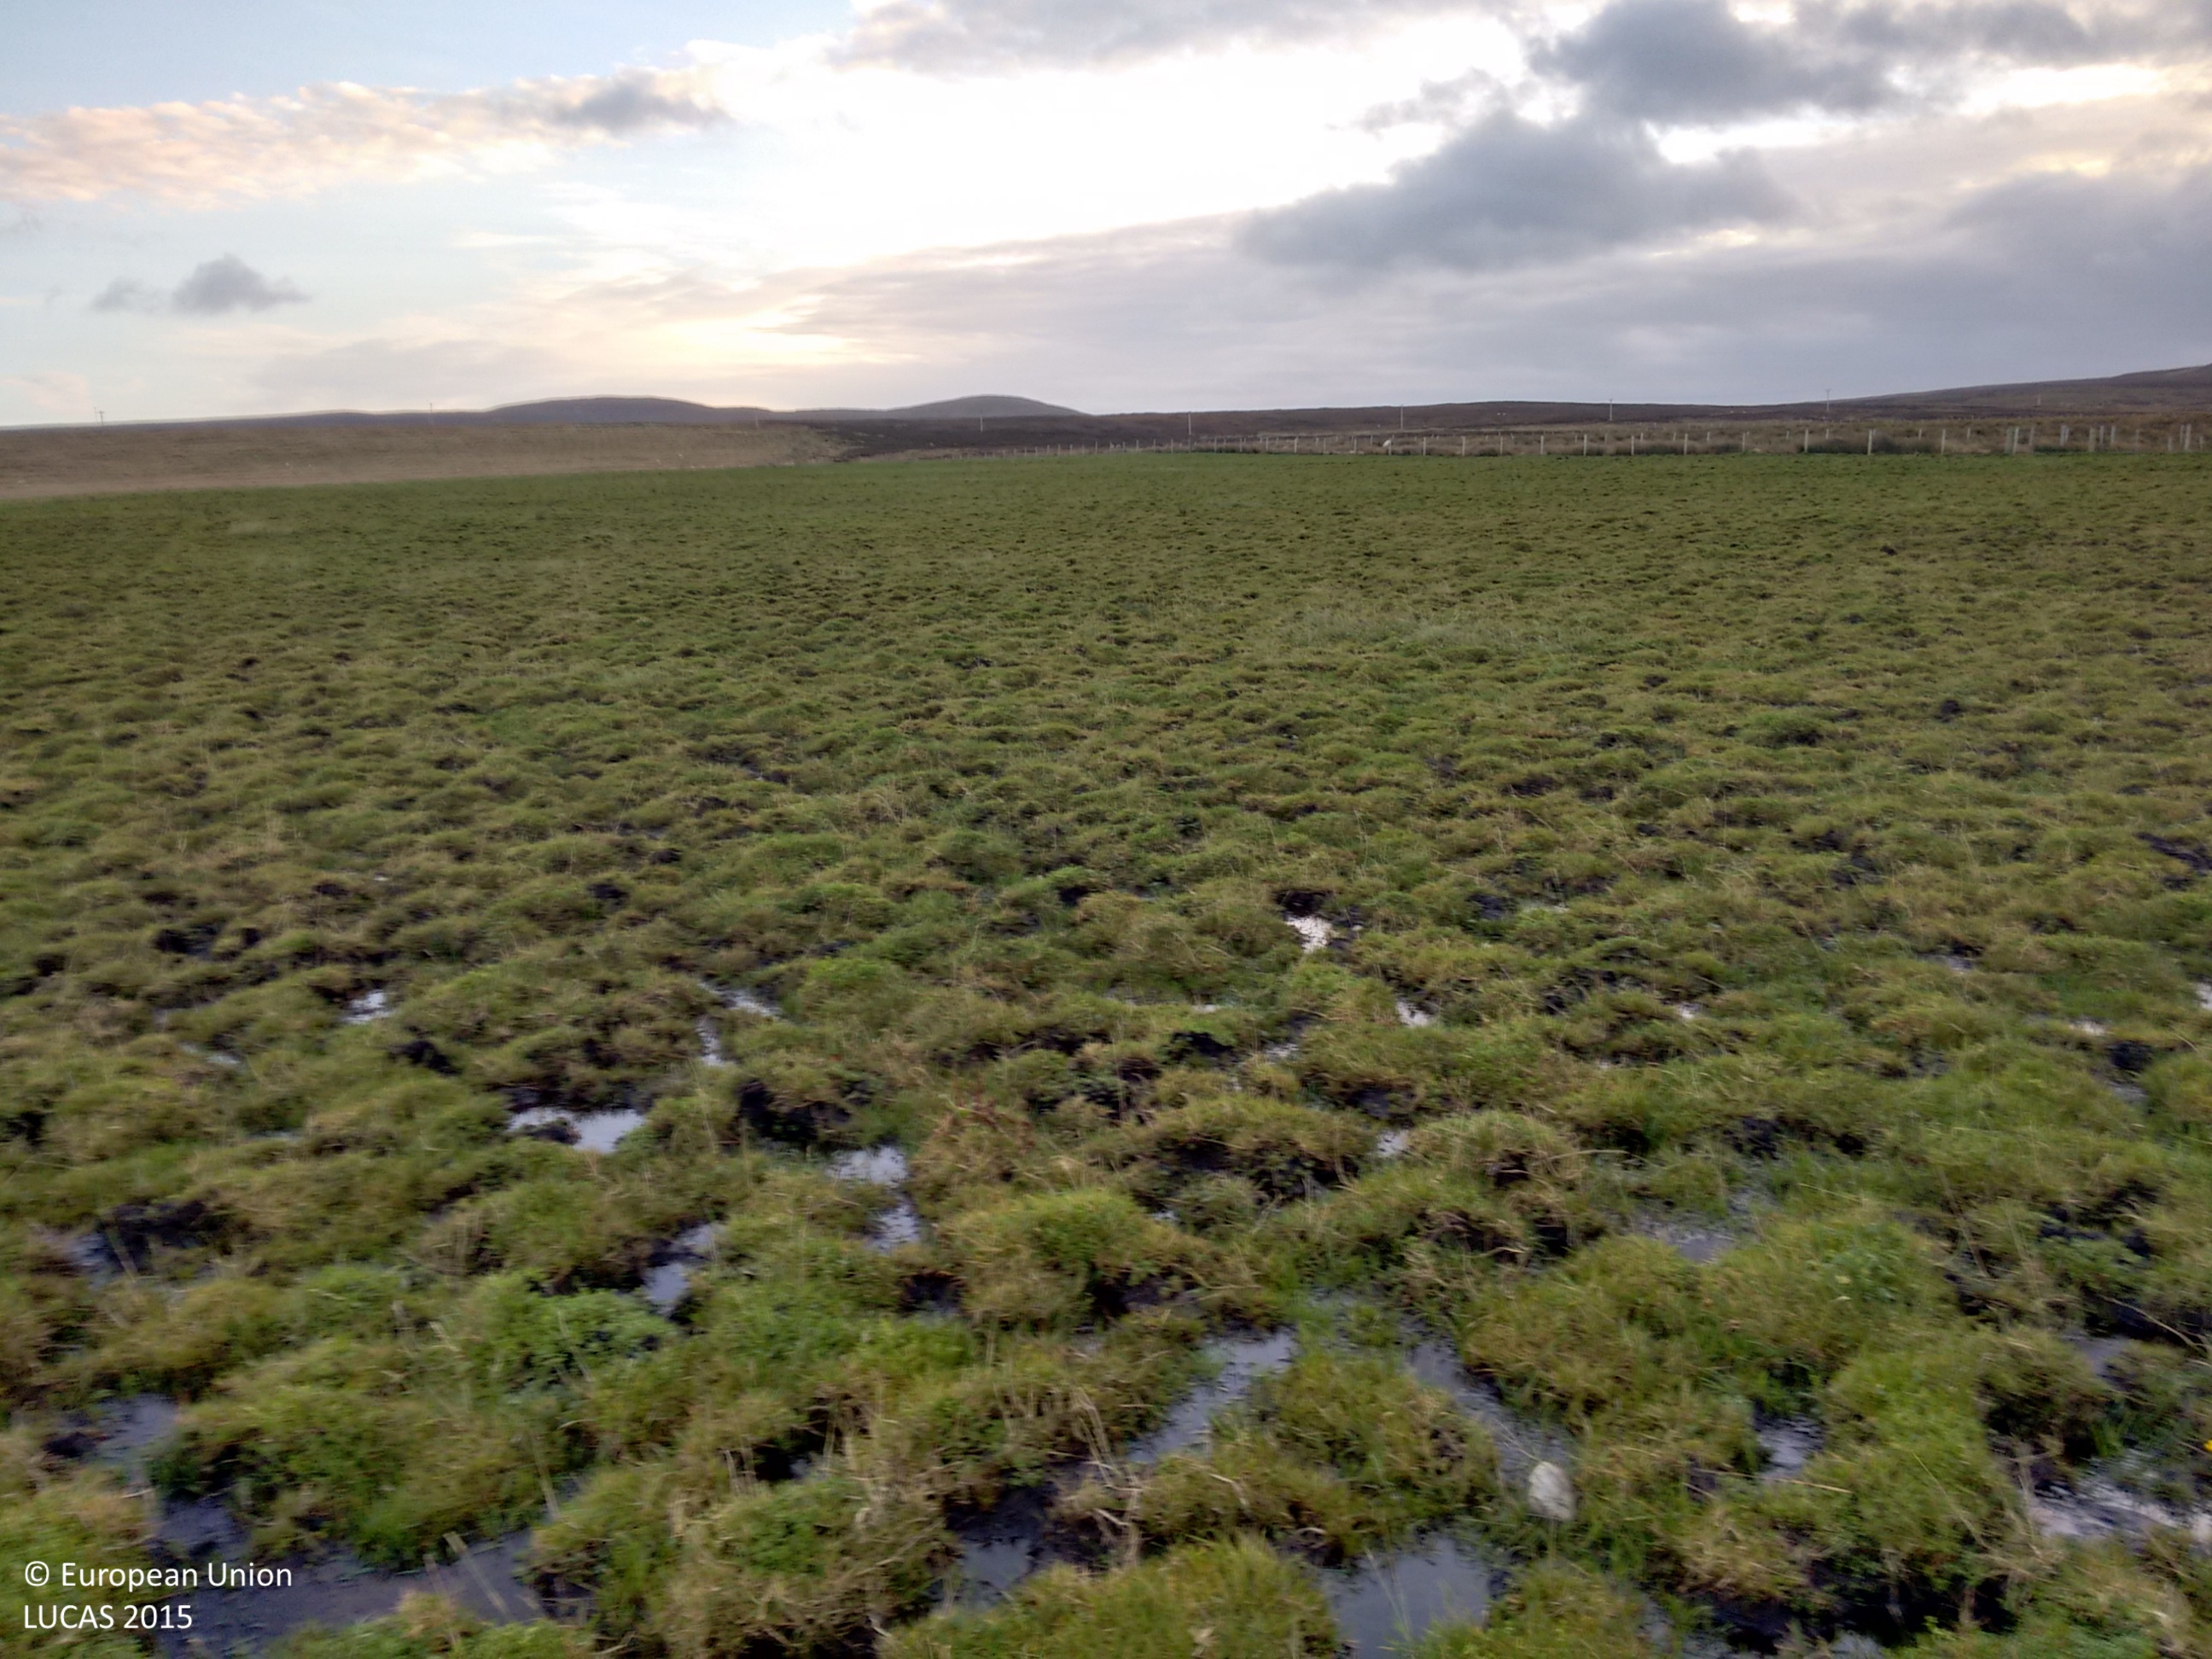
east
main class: Grassland
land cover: Grassland without tree/shrub cover
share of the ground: > 75 %
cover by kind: herbaceous plants 70 %, unconsolidated bare surface 30 %
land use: Agriculture (excluding fallow land and kitchen gardens)
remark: Temporary flooded
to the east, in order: Grassland without tree/shrub cover; Fences; Grassland without tree/shrub cover; Fences; Shrubland without tree cover
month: November
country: GB
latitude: 58.9518
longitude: -3.2155
